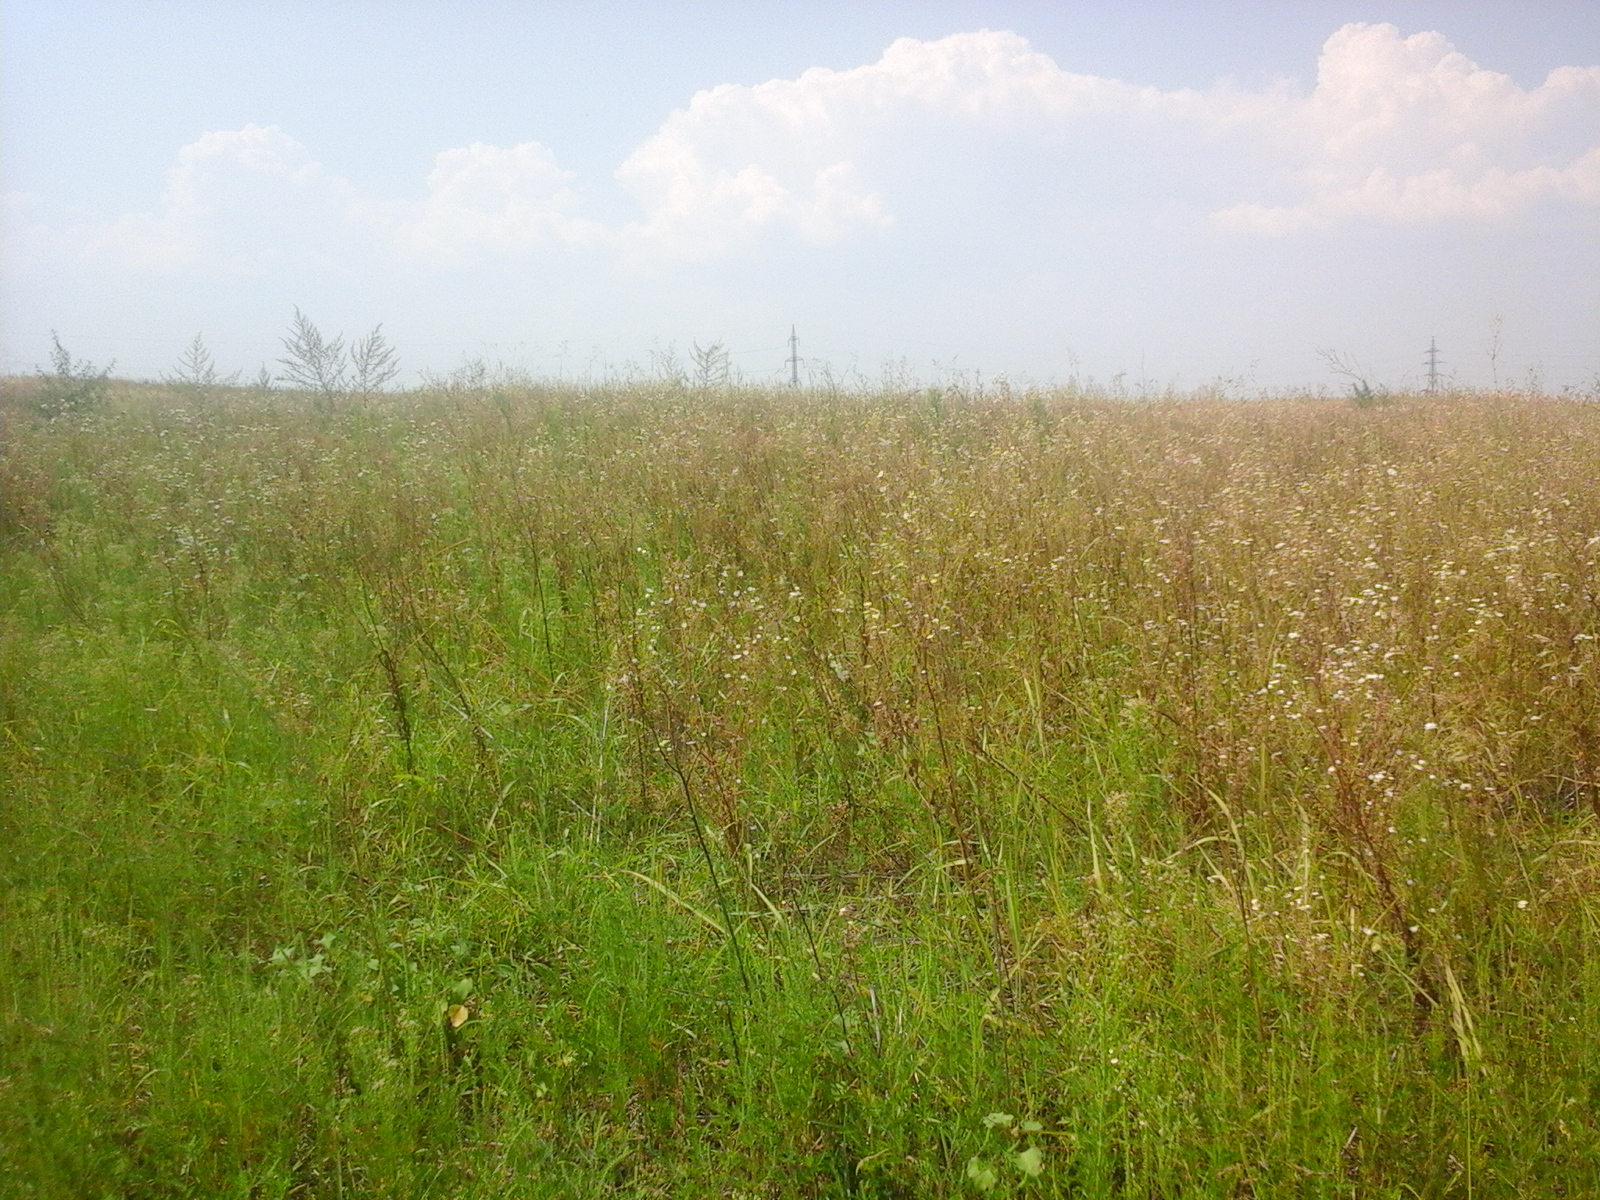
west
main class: Grassland
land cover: Spontaneously vegetated surfaces
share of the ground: > 75 %
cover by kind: herbaceous plants 100 %
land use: Fallow land
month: August
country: RO
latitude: 44.3811
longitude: 22.6029
